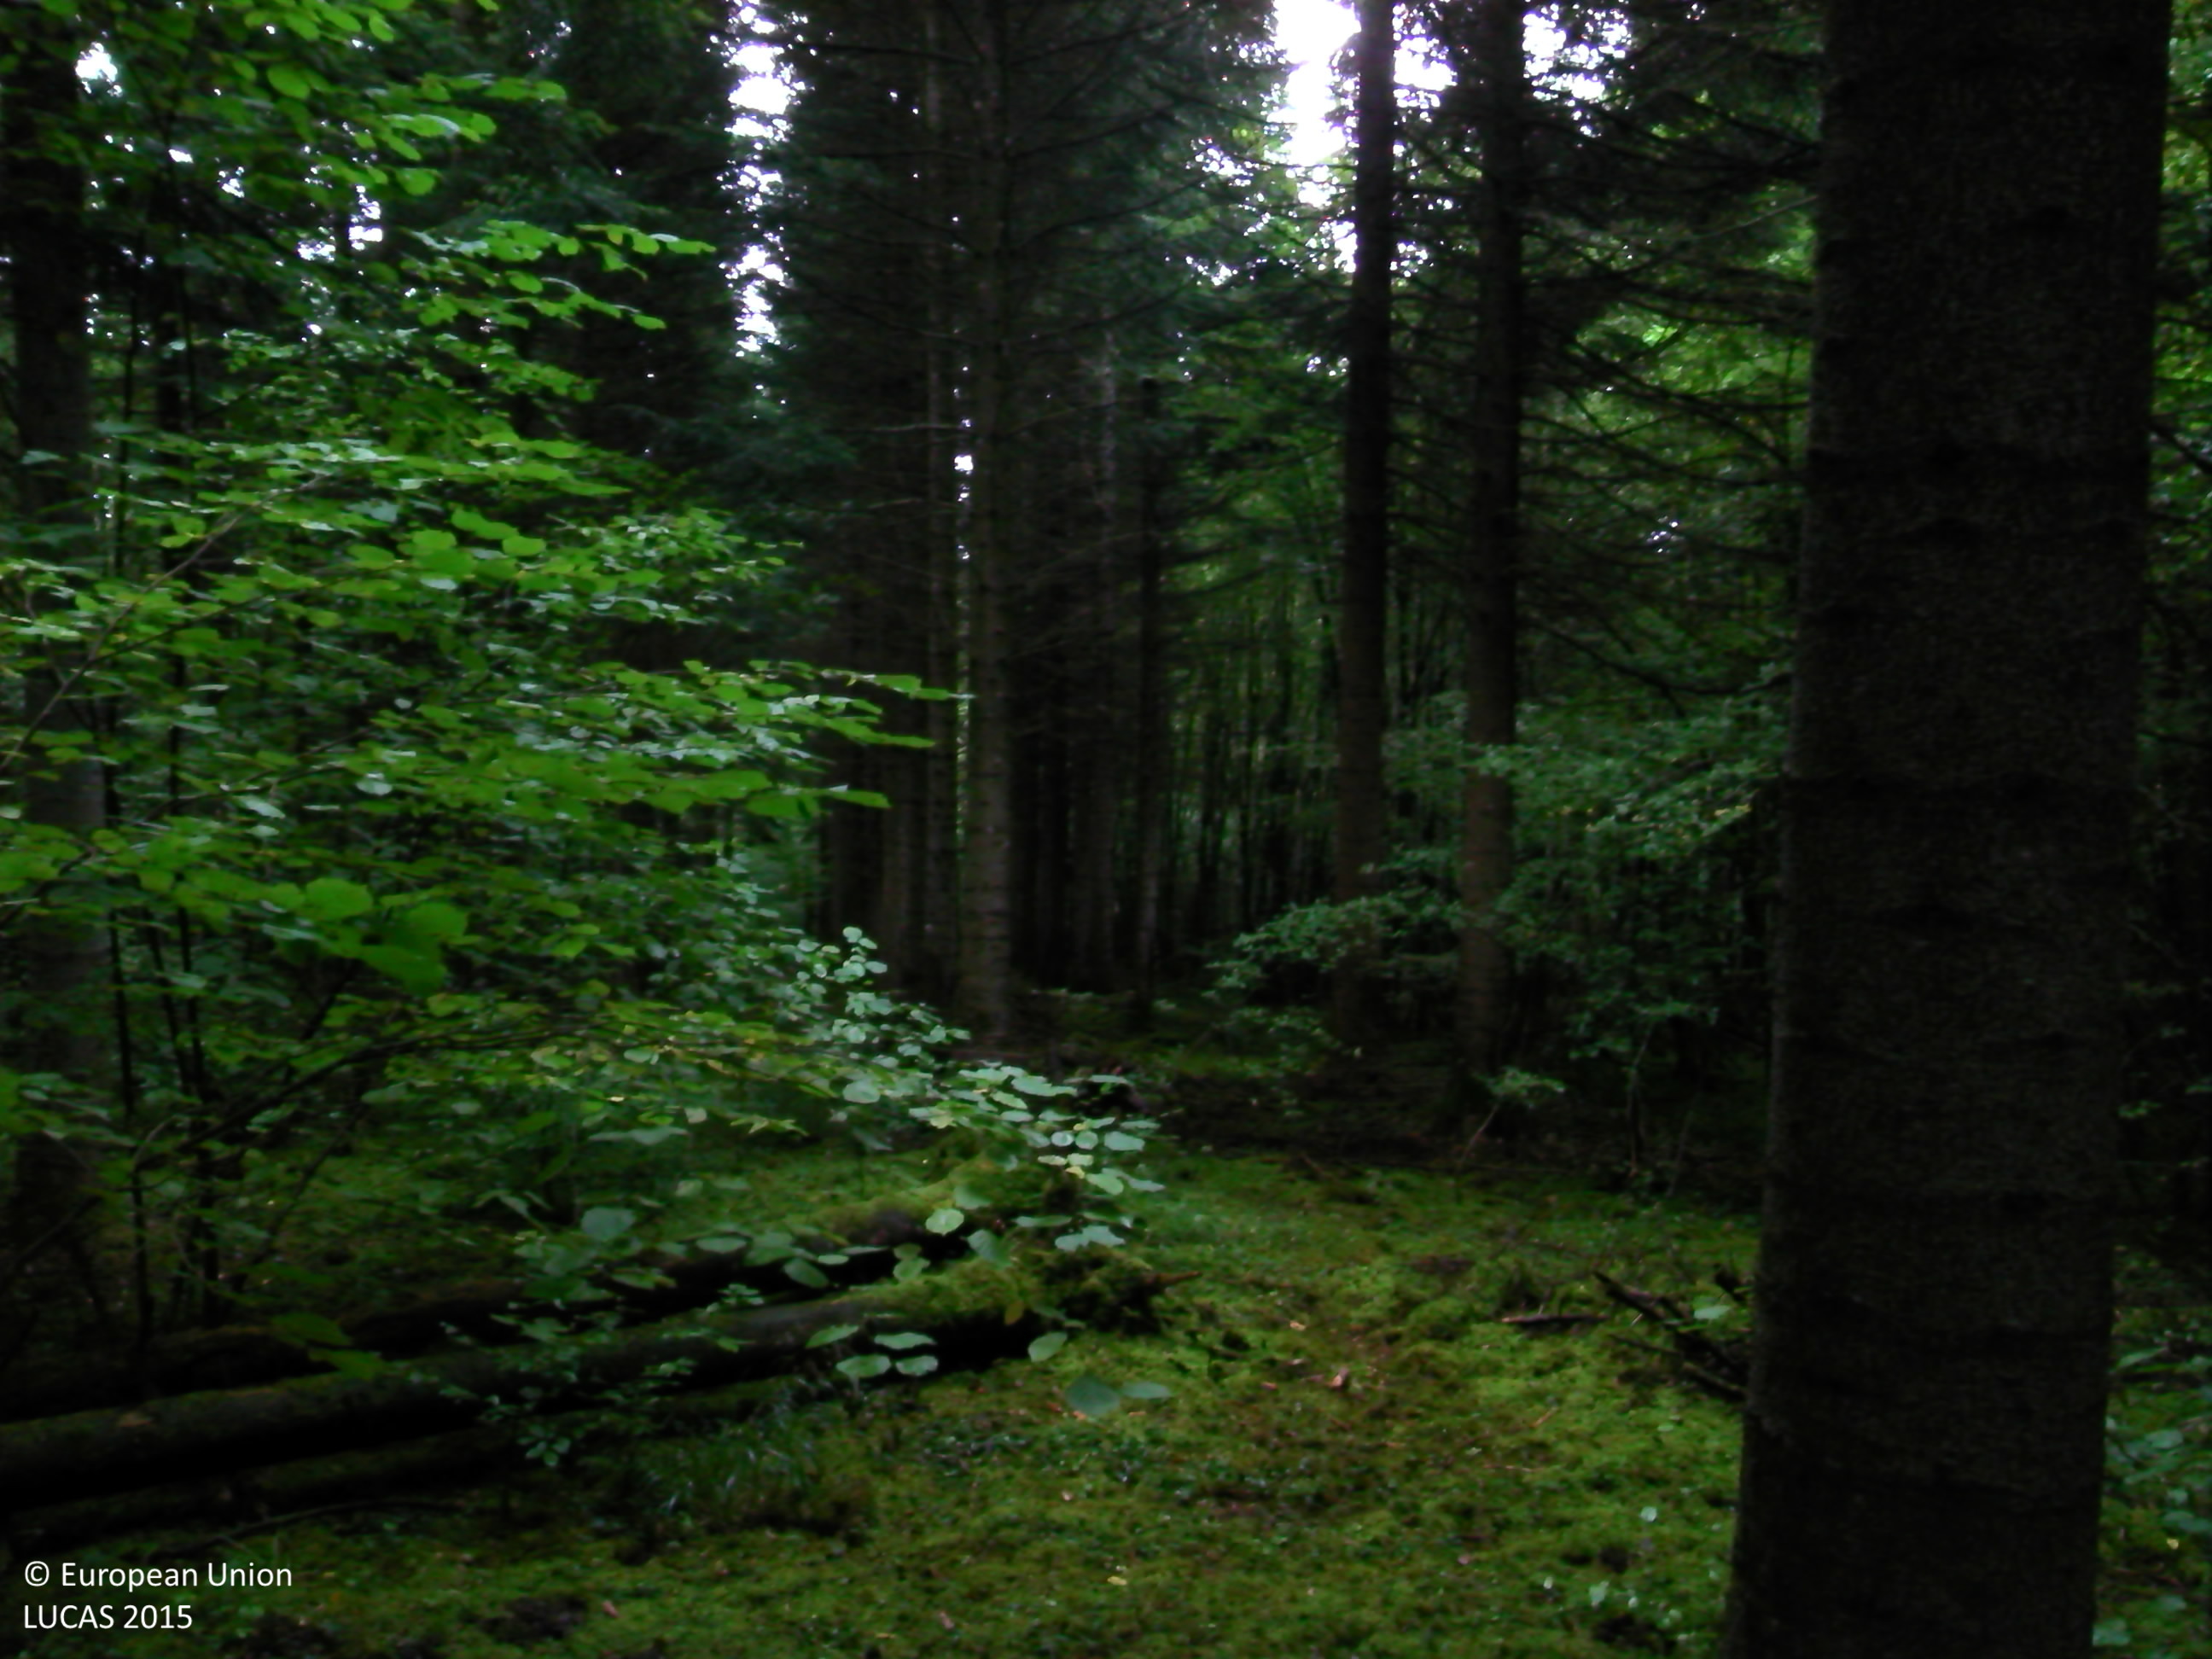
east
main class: Woodland
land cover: Spruce dominated mixed woodland
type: hemiboreal forest and nemoral coniferous forest and mixed broadleaved-coniferous forest
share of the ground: > 75 %
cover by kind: coniferous forest trees 40 %, broadleaved forest trees 40 %, lichens and mosses 15 %, herbaceous plants 5 %
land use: Forestry
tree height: > 5 m
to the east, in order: Spruce dominated mixed woodland; Tracks; Broadleaved woodland; Tracks; Broadleaved woodland; Tracks; Broadleaved woodland
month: September
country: FR
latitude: 48.0228
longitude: 4.6753
